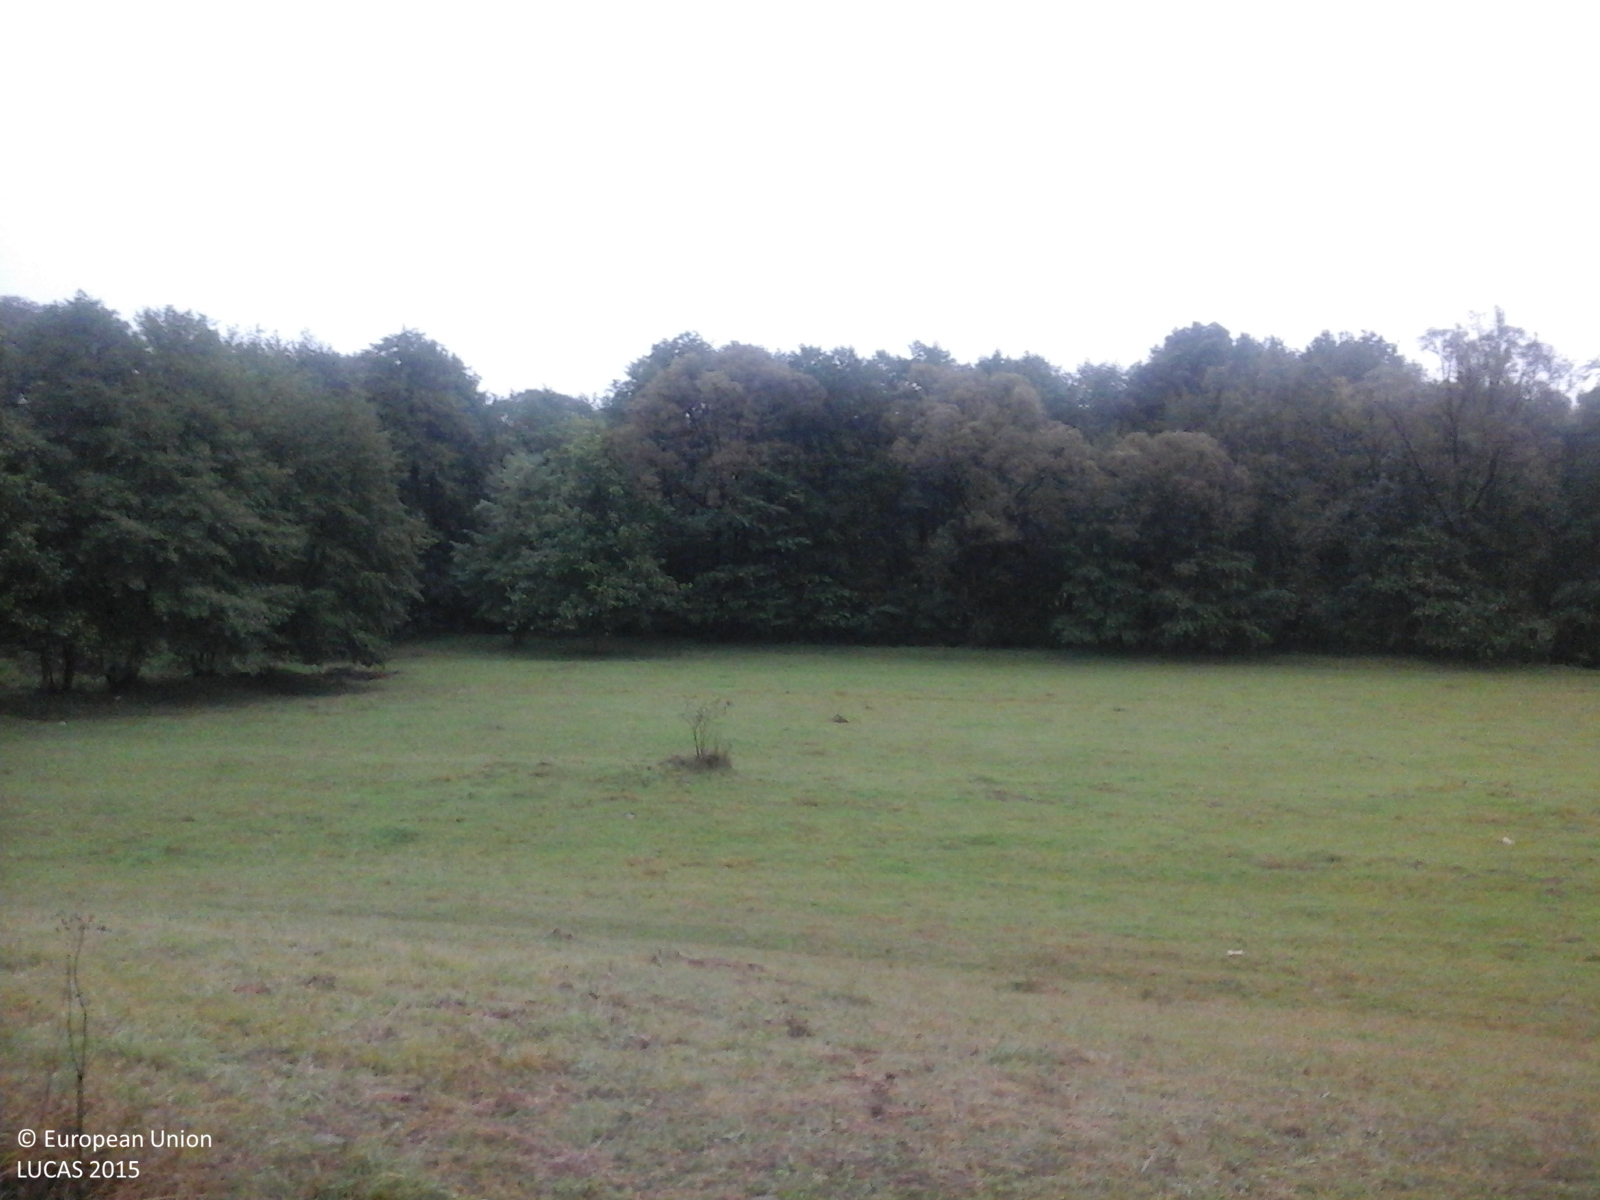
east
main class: Grassland
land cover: Grassland with sparse tree/shrub cover
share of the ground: > 75 %
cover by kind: herbaceous plants 95 %, broadleaved forest trees 5 %
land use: Agriculture (excluding fallow land and kitchen gardens)
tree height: < 5 m
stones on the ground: < 10 %
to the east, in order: Grassland with sparse tree/shrub cover; Grassland without tree/shrub cover; Broadleaved woodland; Rivers and streams; Broadleaved woodland; Grassland without tree/shrub cover
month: September
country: RO
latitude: 45.1529
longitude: 23.7103
